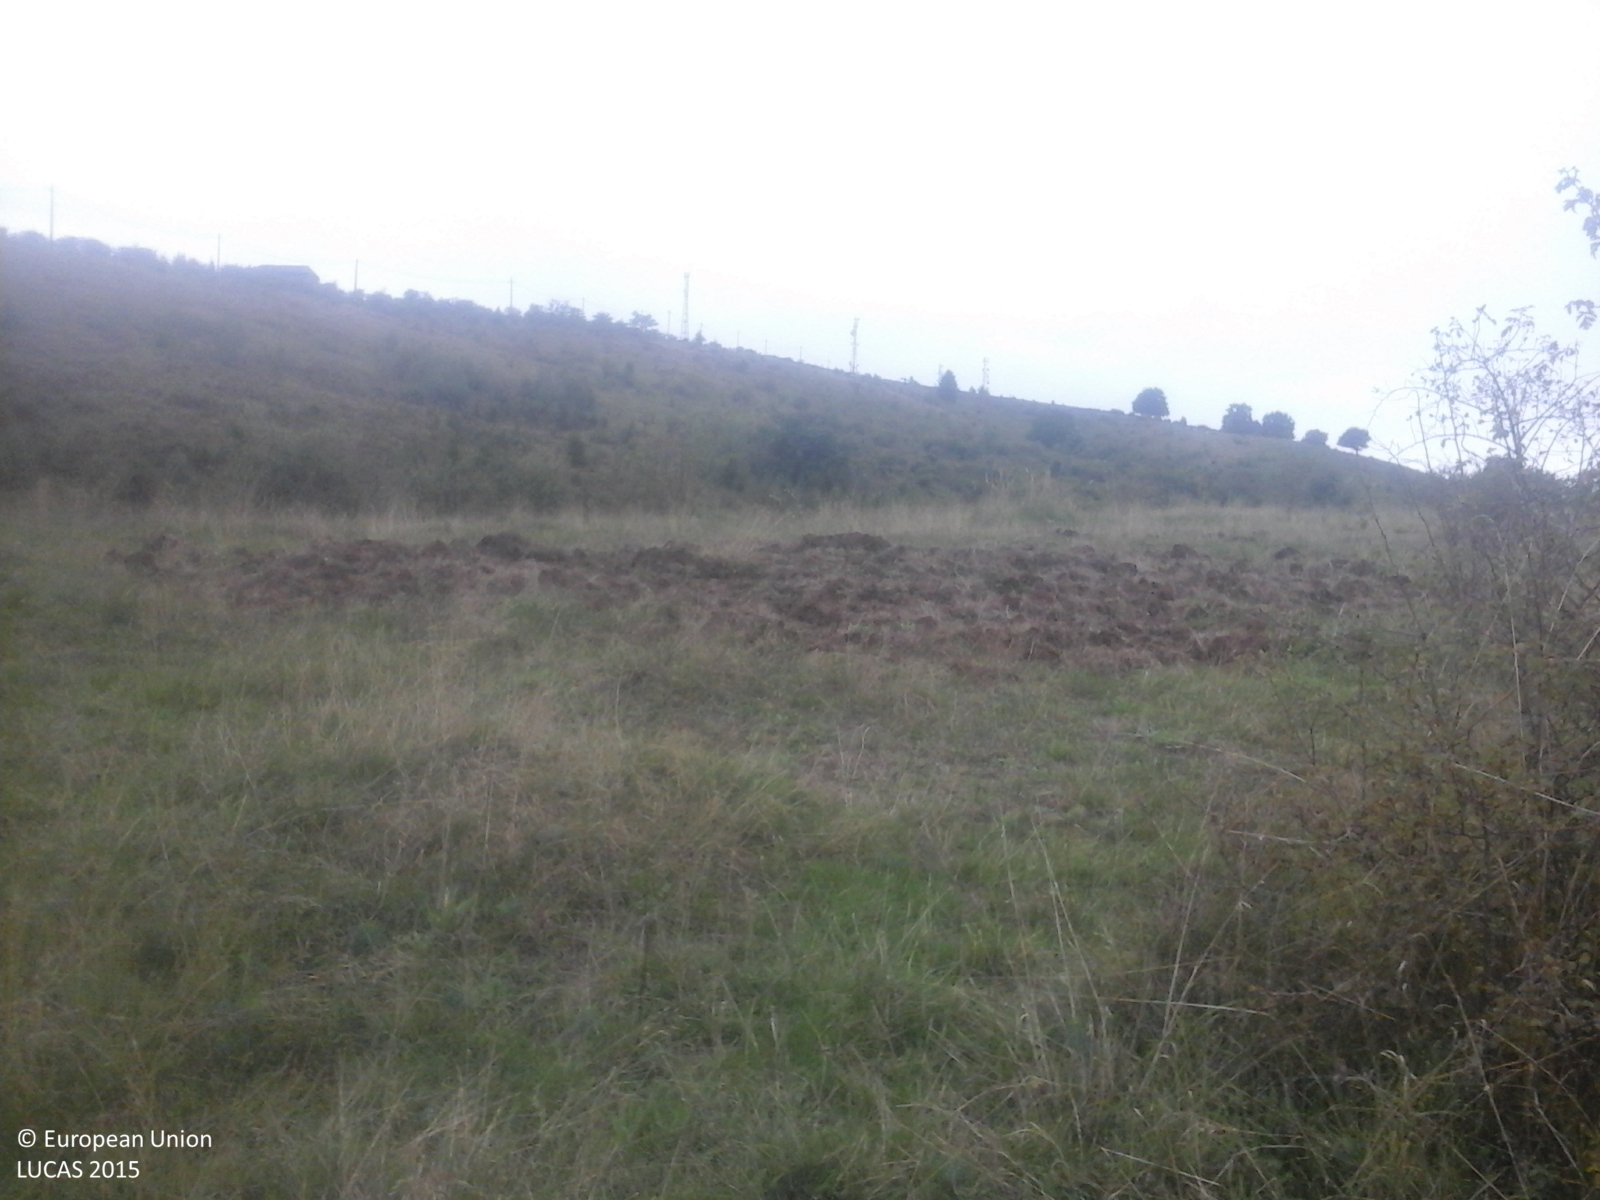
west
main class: Grassland
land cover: Grassland with sparse tree/shrub cover
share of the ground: > 75 %
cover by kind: herbaceous plants 85 %, shrubs 10 %, broadleaved forest trees 5 %
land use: Fallow land
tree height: < 5 m
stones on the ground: < 10 %
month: September
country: RO
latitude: 45.8067
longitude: 23.8769
